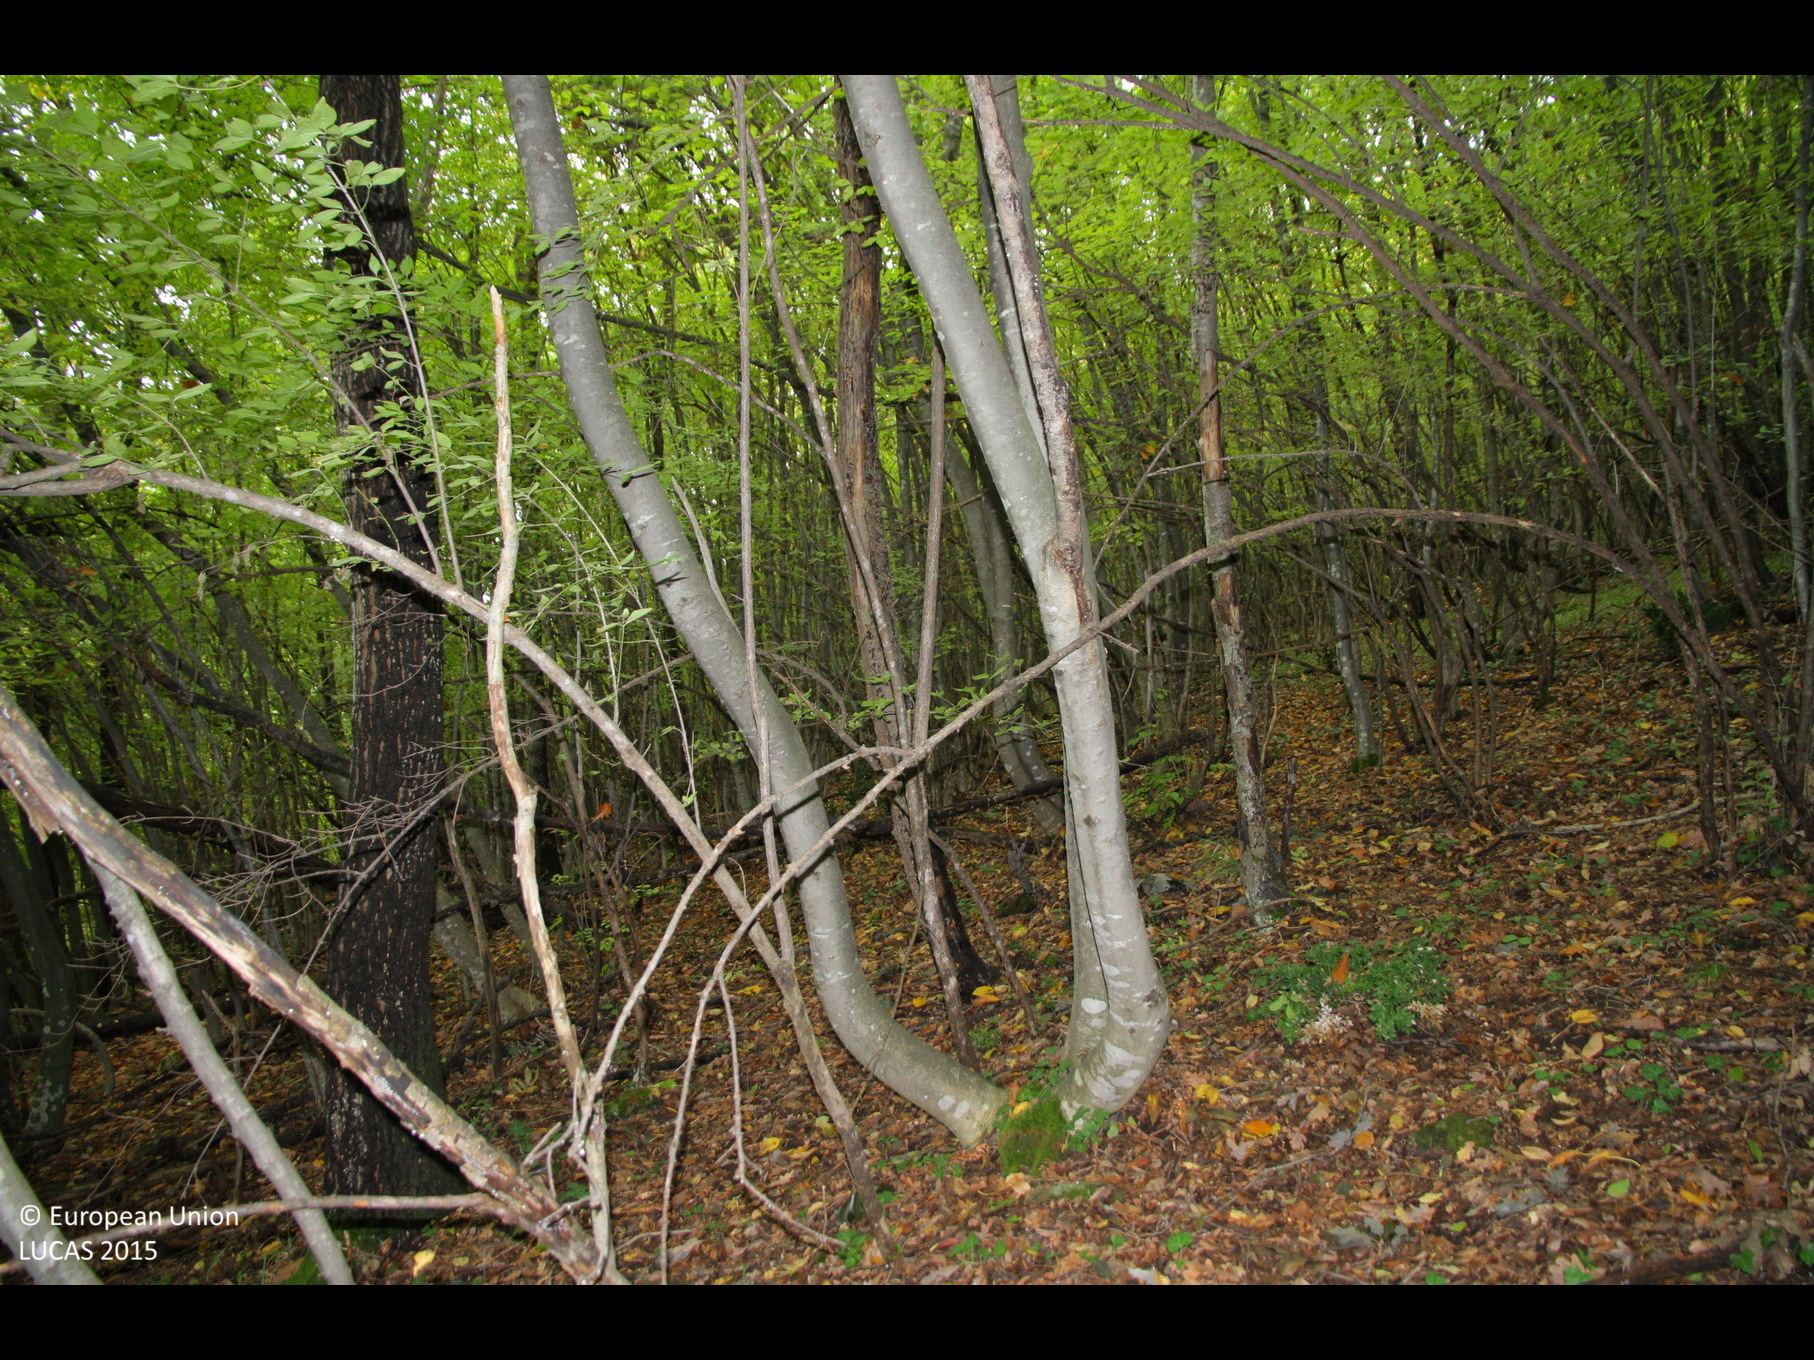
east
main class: Woodland
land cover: Broadleaved woodland
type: beech forest
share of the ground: > 75 %
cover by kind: broadleaved forest trees 100 %
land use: Forestry
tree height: > 5 m
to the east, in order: Broadleaved woodland
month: October
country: BG
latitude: 43.4718
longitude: 27.0922
